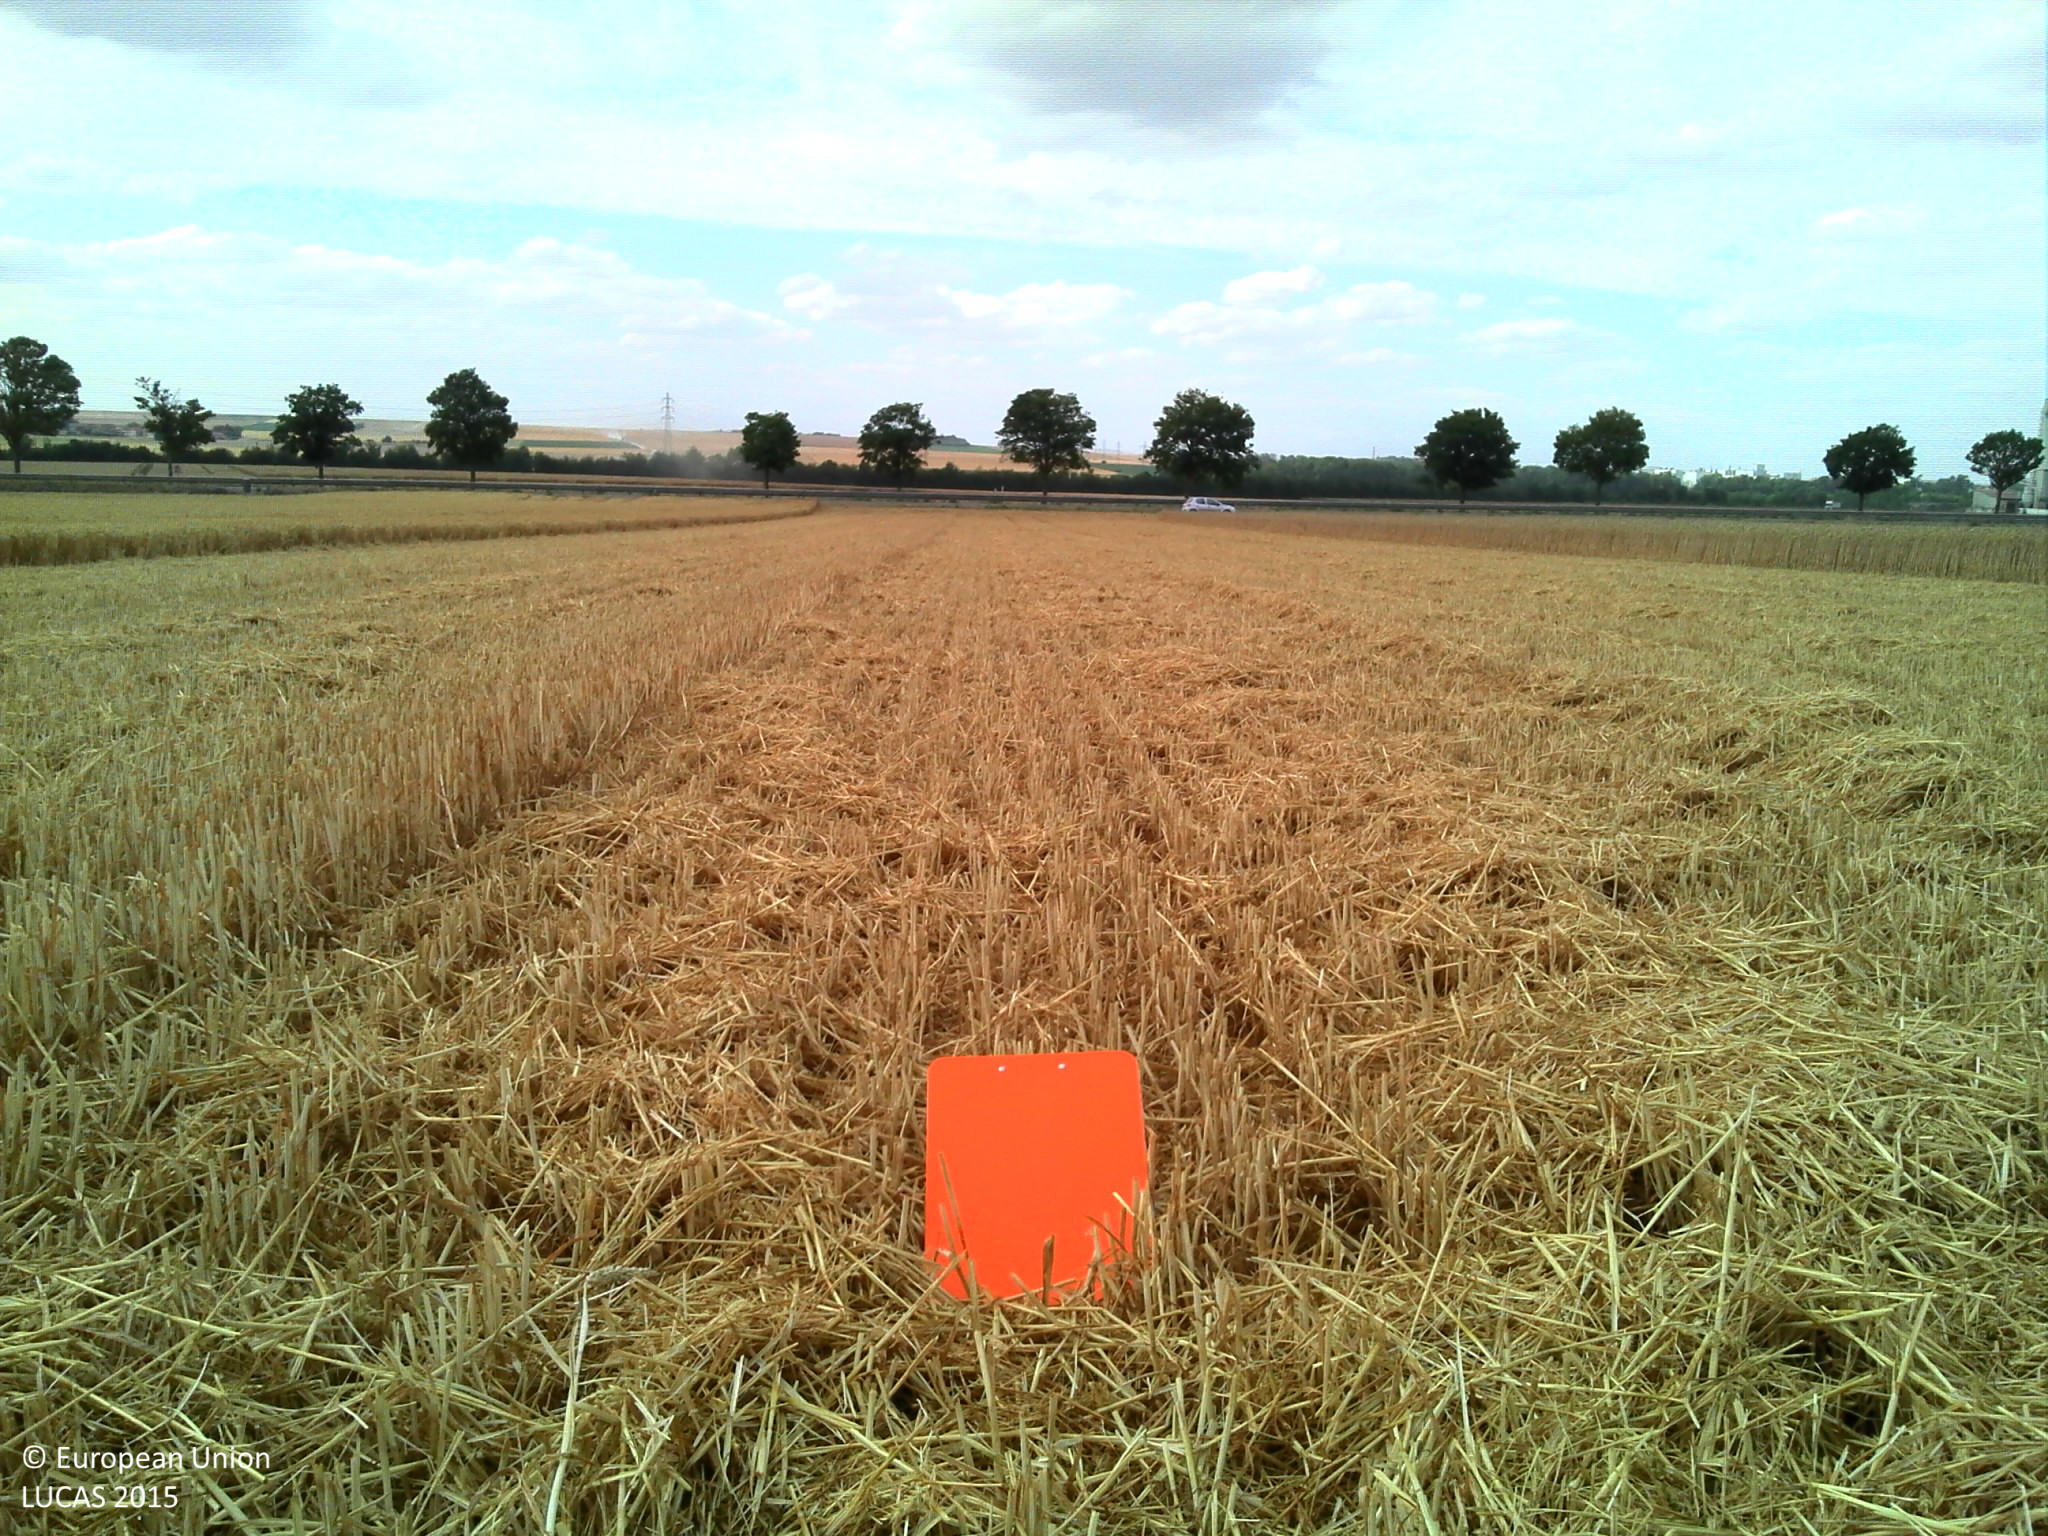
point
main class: Cropland
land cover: Common wheat
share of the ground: > 75 %
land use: Agriculture (excluding fallow land and kitchen gardens)
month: July
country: FR
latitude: 49.3321
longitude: 4.1746
